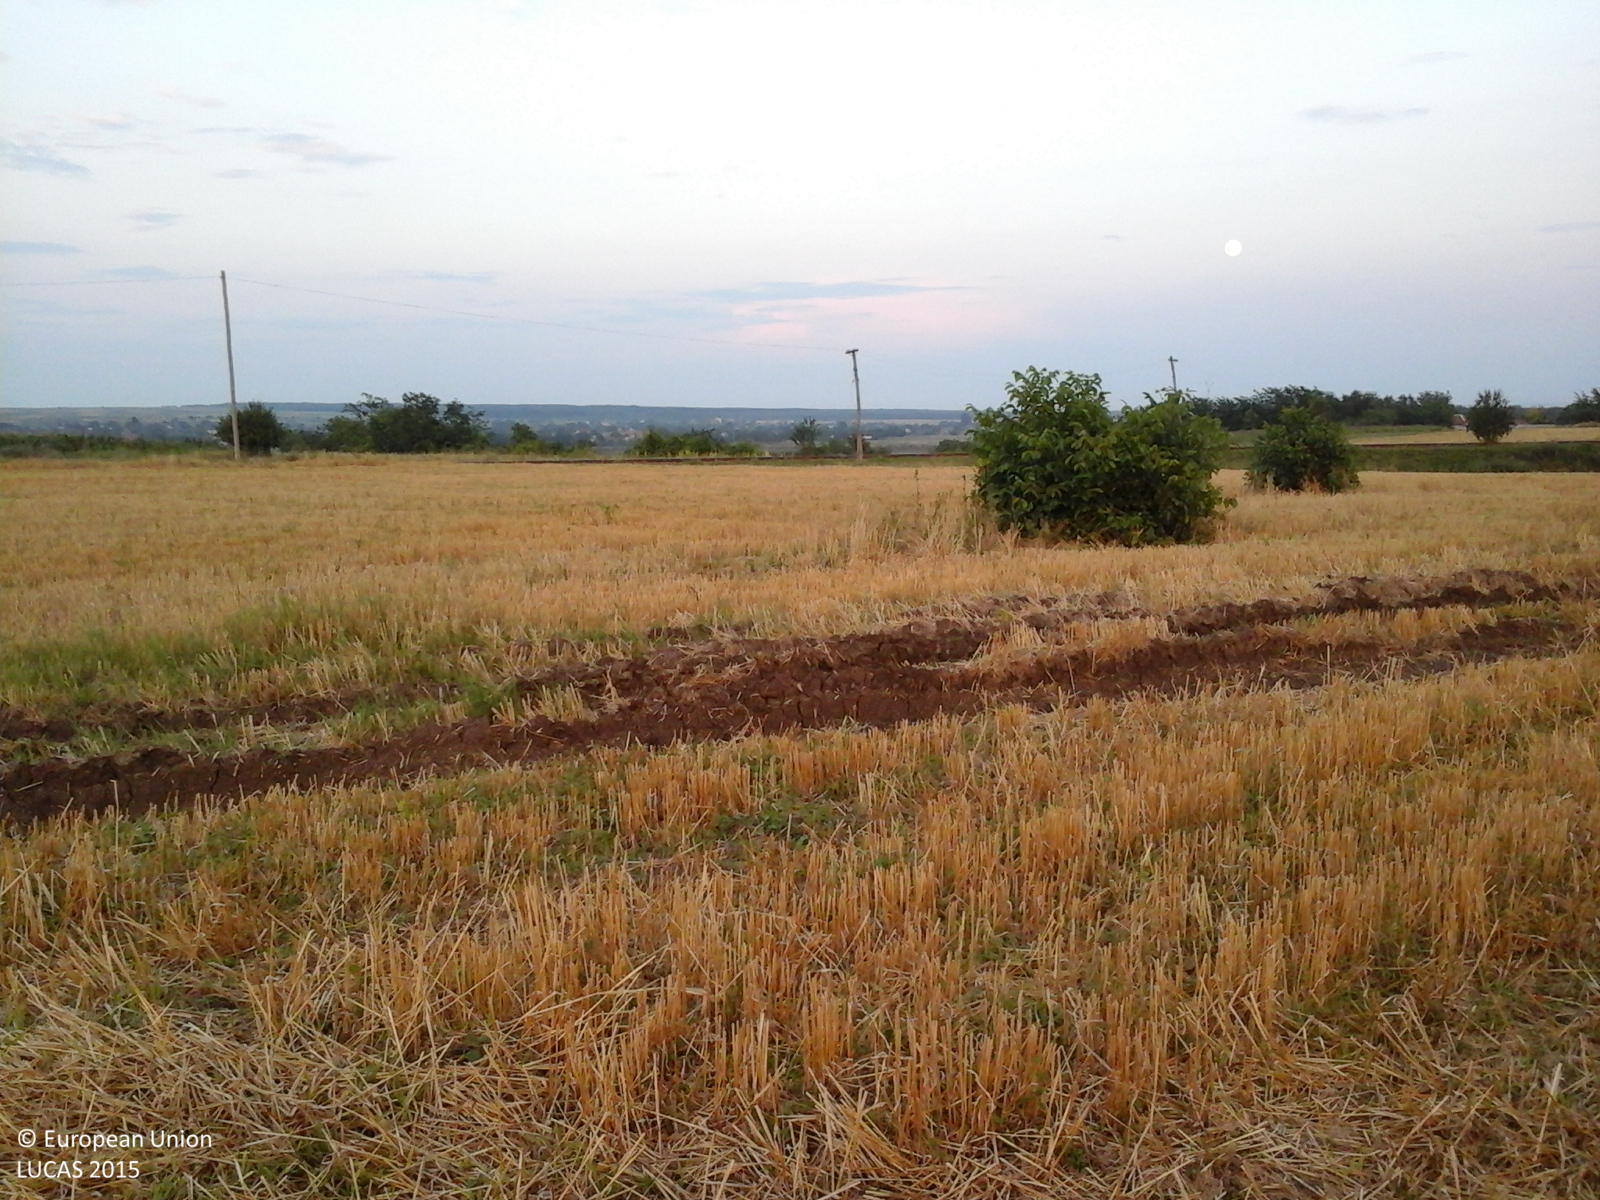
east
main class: Cropland
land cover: Common wheat
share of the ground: < 10 %
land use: Agriculture (excluding fallow land and kitchen gardens)
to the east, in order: Common wheat; Electric lines; Common wheat; Tracks; Grass margins; Railways; Grassland without tree/shrub cover; Abandoned hedges; Fences; Grassland with sparse tree/shrub cover
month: July
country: RO
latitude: 43.8283
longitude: 25.4411
